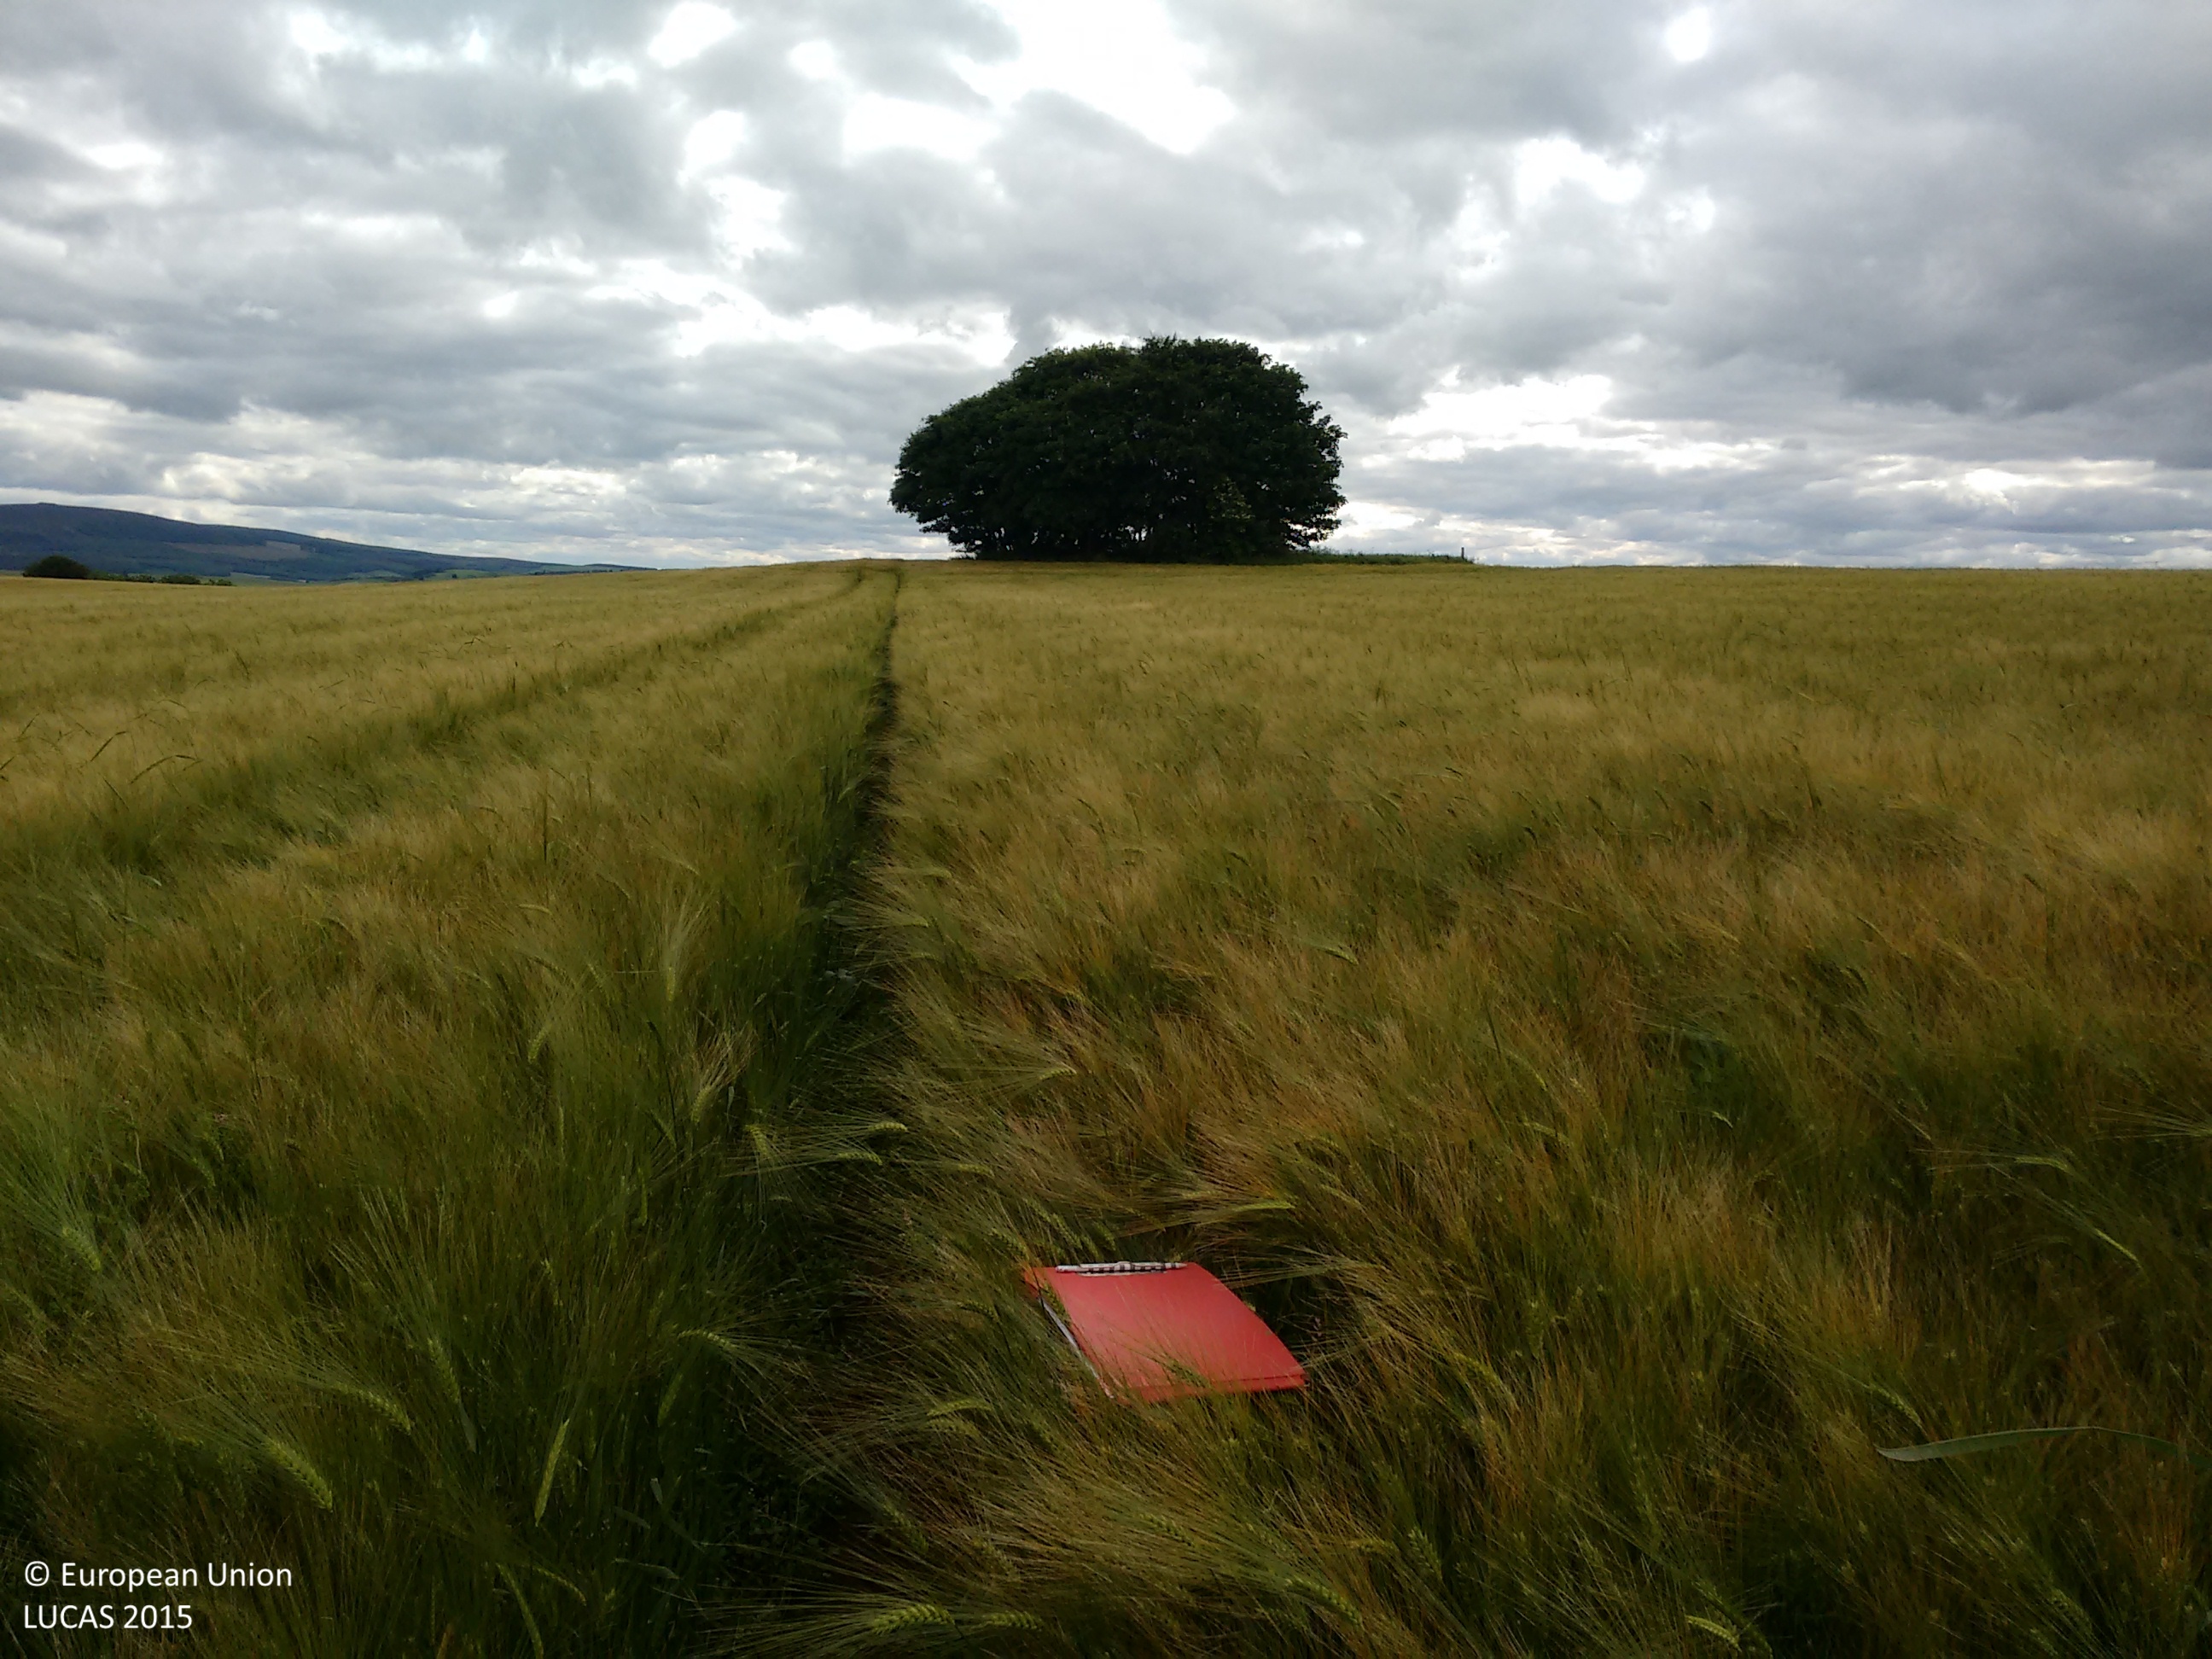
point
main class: Cropland
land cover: Barley
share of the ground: > 75 %
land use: Agriculture (excluding fallow land and kitchen gardens)
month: July
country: GB
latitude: 57.3705
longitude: -2.5758
